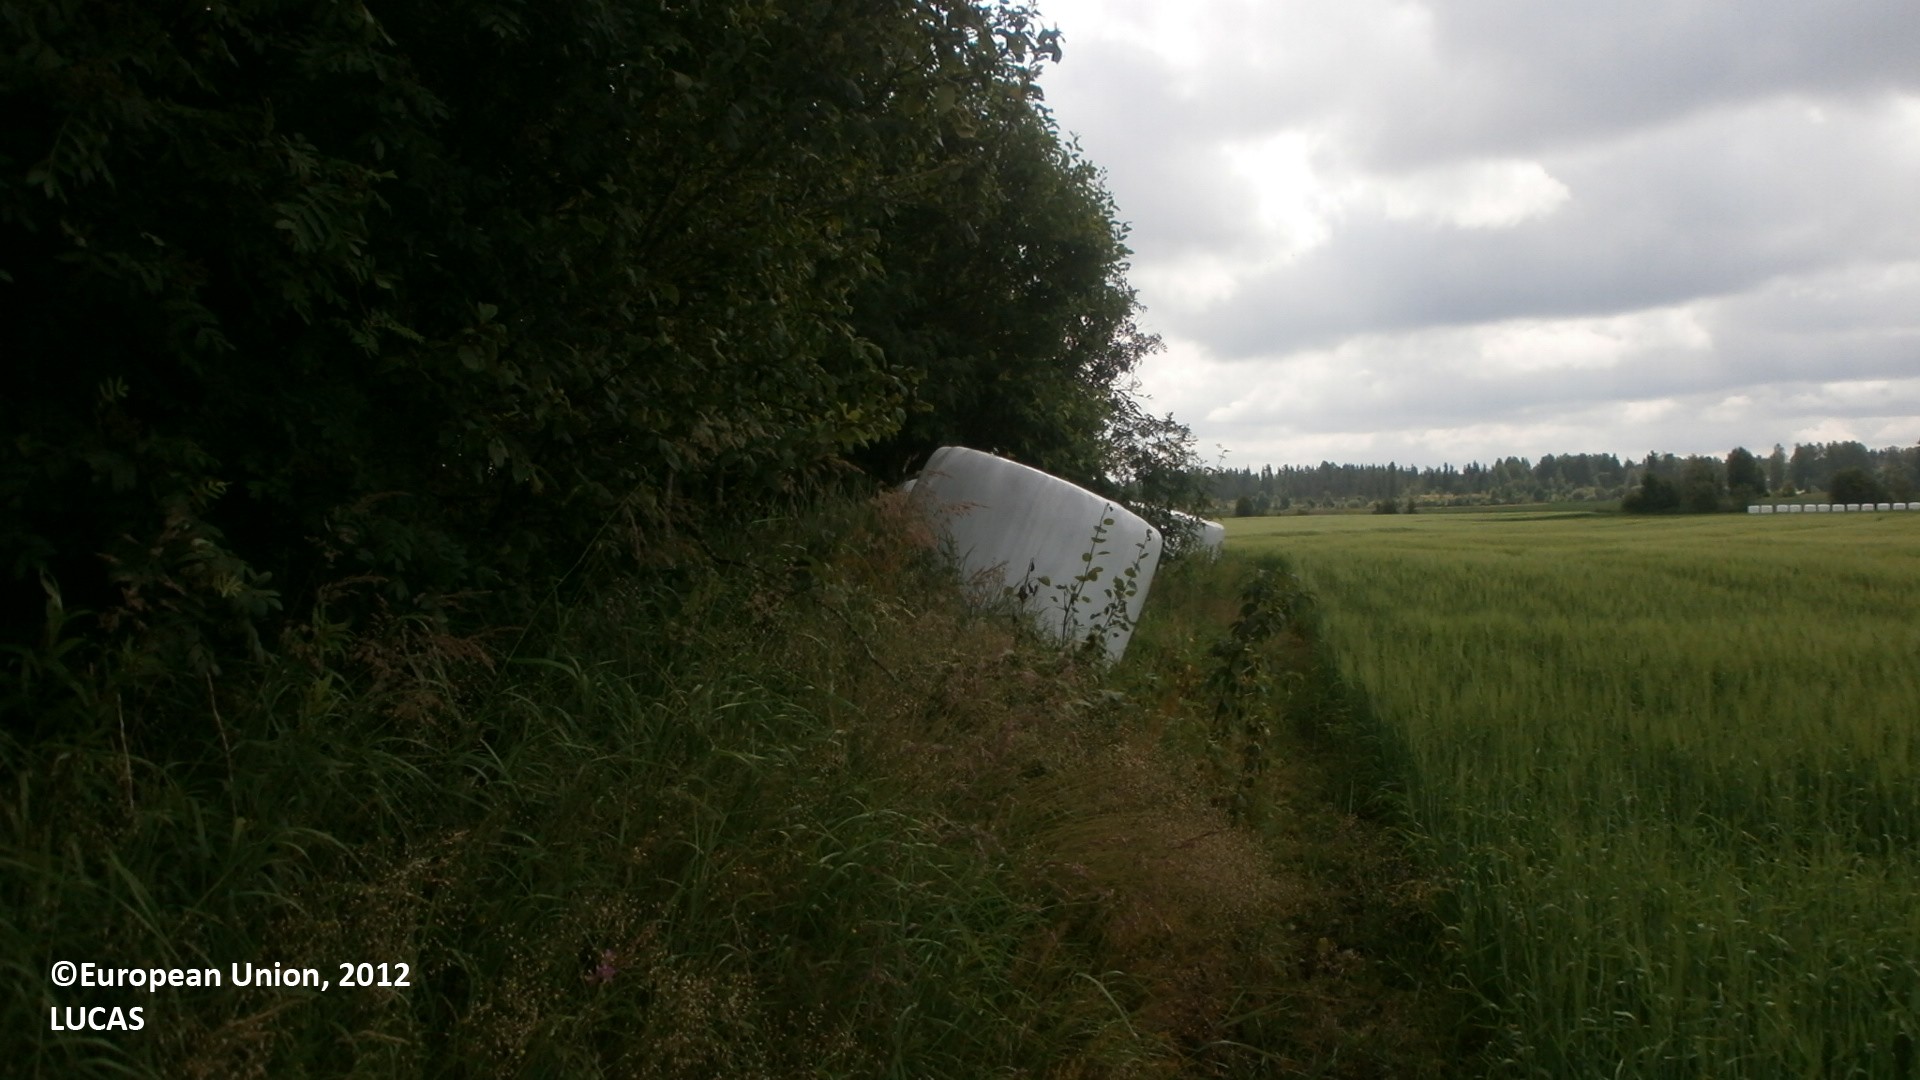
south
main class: Cropland
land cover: Barley
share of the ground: > 75 %
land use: Agriculture (excluding fallow land and kitchen gardens)
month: July
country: FI
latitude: 64.1851
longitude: 24.3328
